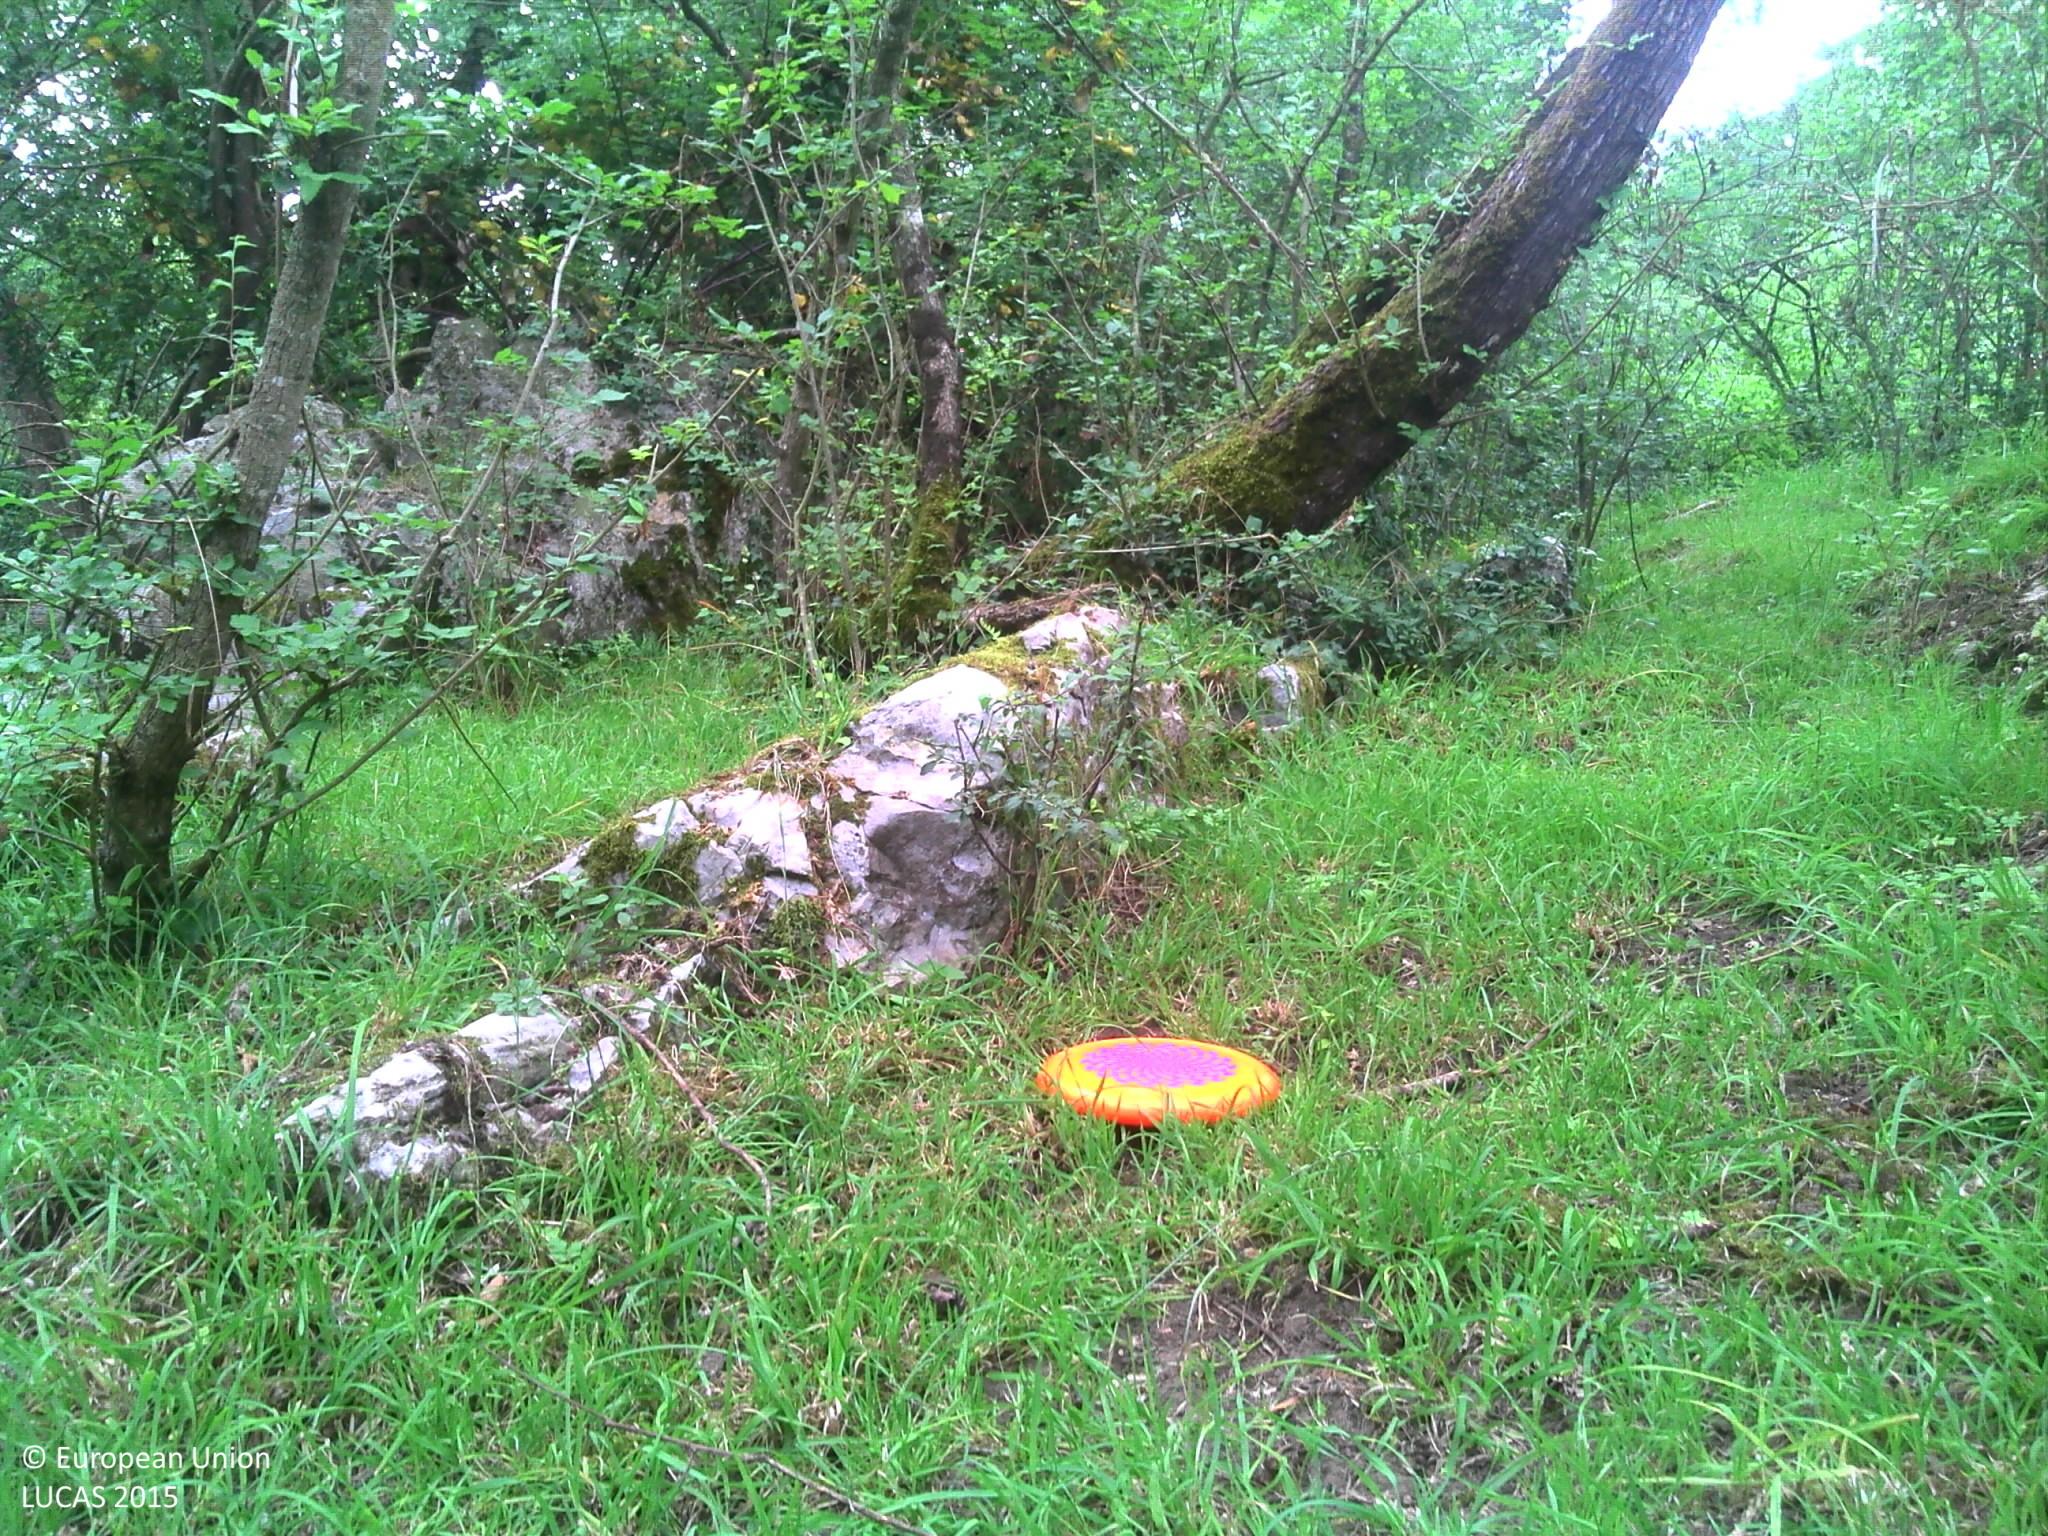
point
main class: Woodland
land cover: Broadleaved woodland
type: mesophytic deciduous forest
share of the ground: > 75 %
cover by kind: broadleaved forest trees 90 %, lichens and mosses 10 %
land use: Forestry
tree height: > 5 m
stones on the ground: 10 - 25 %
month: June
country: FR
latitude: 48.8051
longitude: 0.0443
